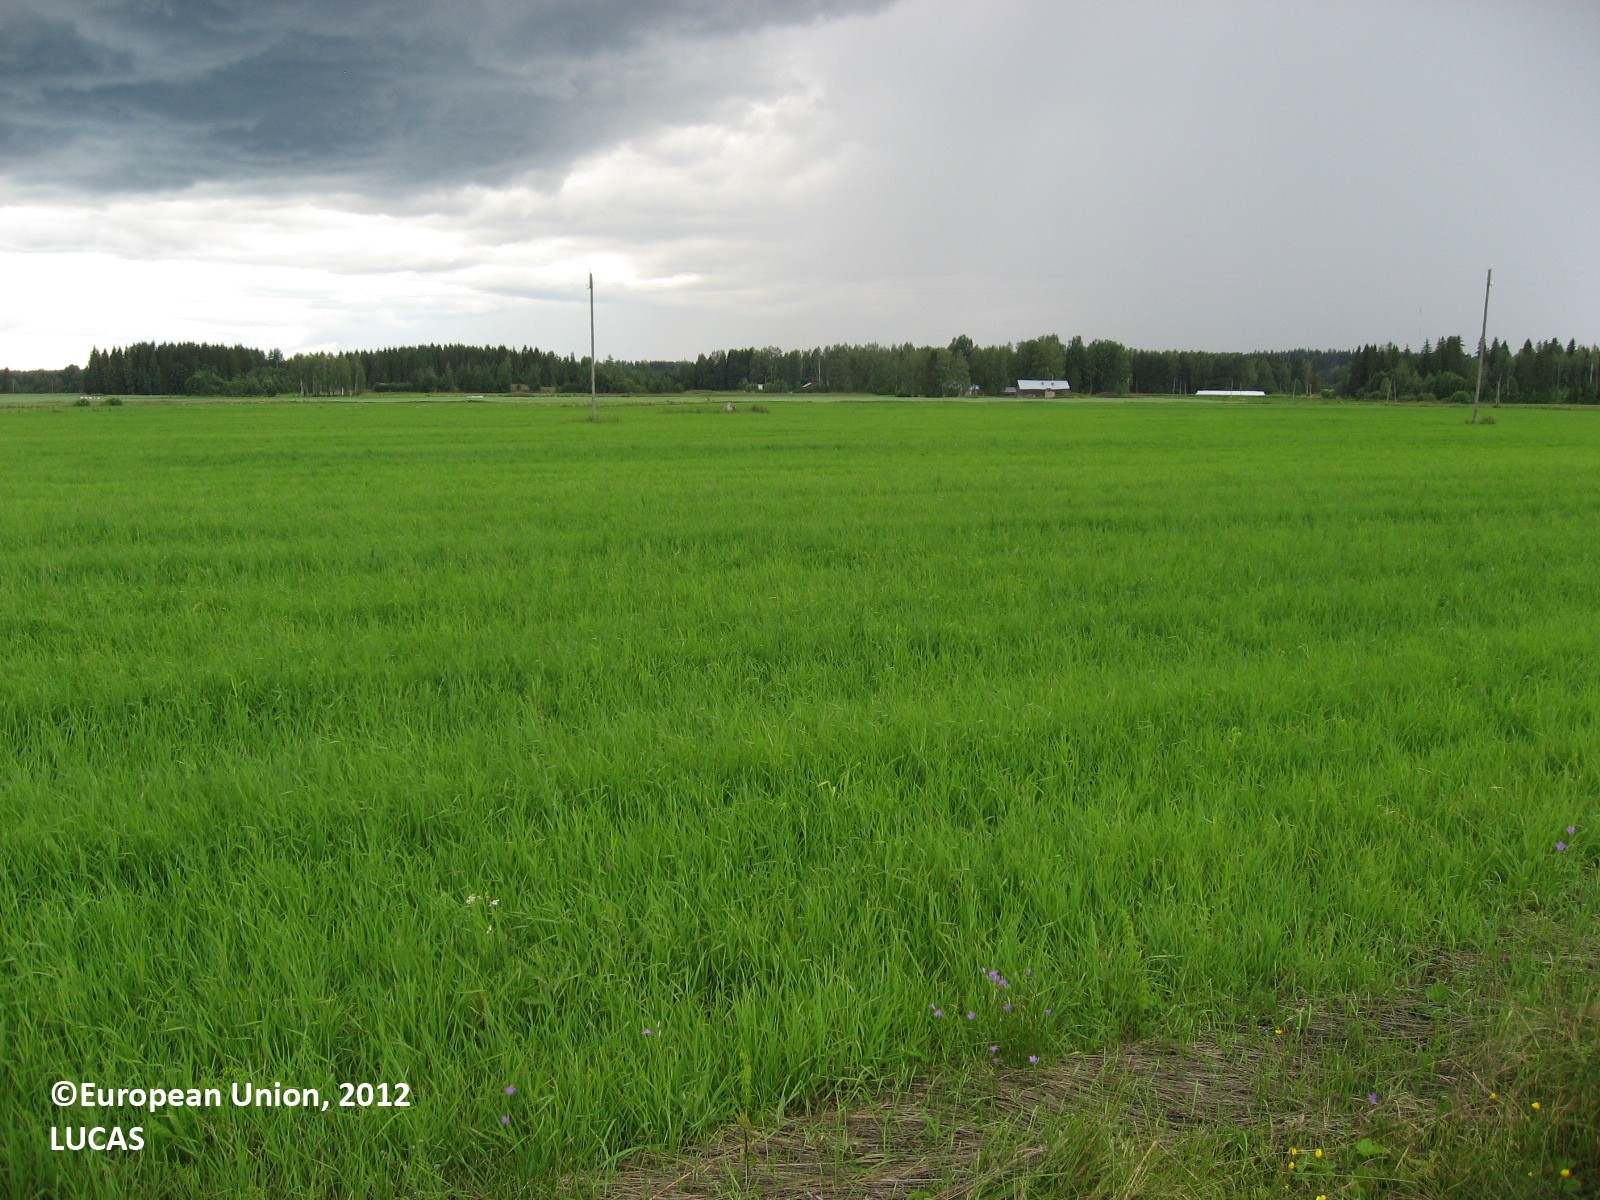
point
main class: Cropland
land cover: Temporary grasslands
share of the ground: > 75 %
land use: Agriculture (excluding fallow land and kitchen gardens)
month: July
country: FI
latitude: 61.3440
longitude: 25.8140
